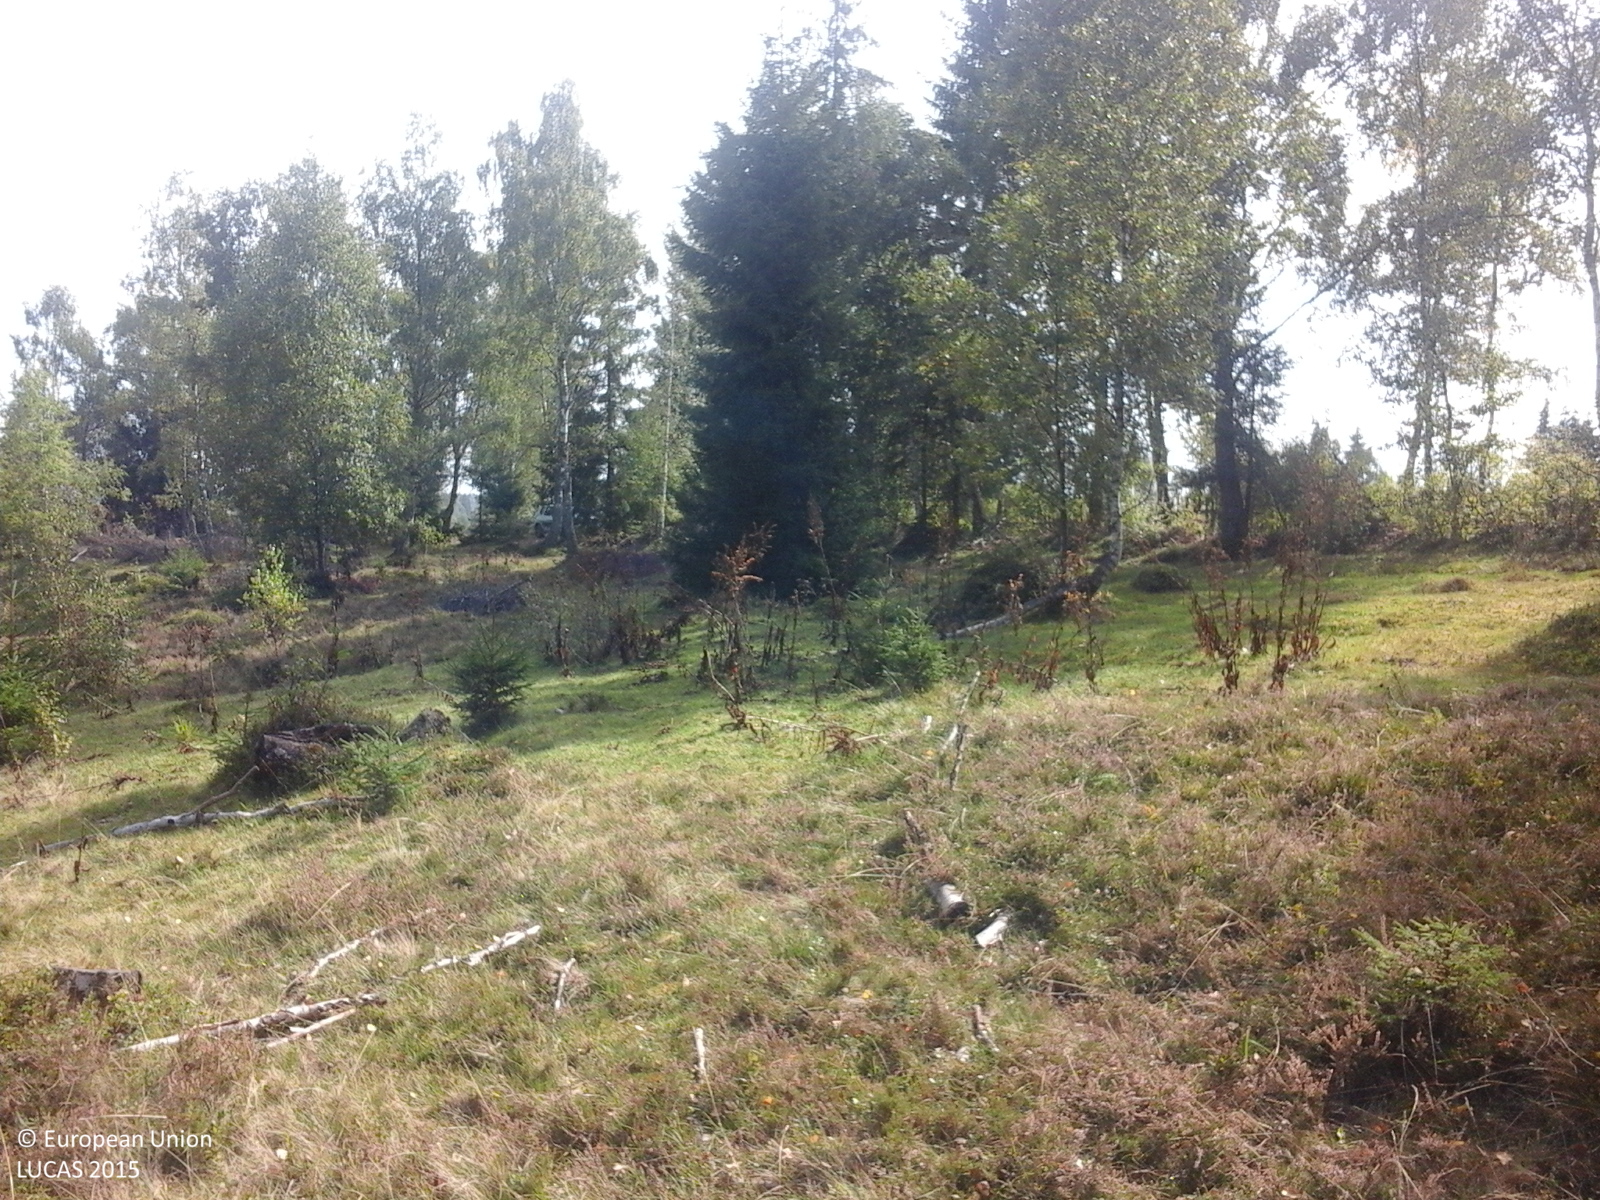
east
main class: Woodland
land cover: Spruce dominated mixed woodland
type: alpine coniferous forest
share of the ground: > 75 %
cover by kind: coniferous forest trees 50 %, broadleaved forest trees 30 %, herbaceous plants 15 %, shrubs 5 %
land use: Forestry
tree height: > 5 m
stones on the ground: < 10 %
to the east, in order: Spruce dominated mixed woodland; Fences; Tracks; Grassland without tree/shrub cover; Artificial constructions in urban areas; Grassland without tree/shrub cover; Electric lines; Grassland with sparse tree/shrub cover; Grassland without tree/shrub cover; Fences; Spontaneously vegetated surfaces
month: September
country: RO
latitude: 46.7144
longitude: 23.0515
